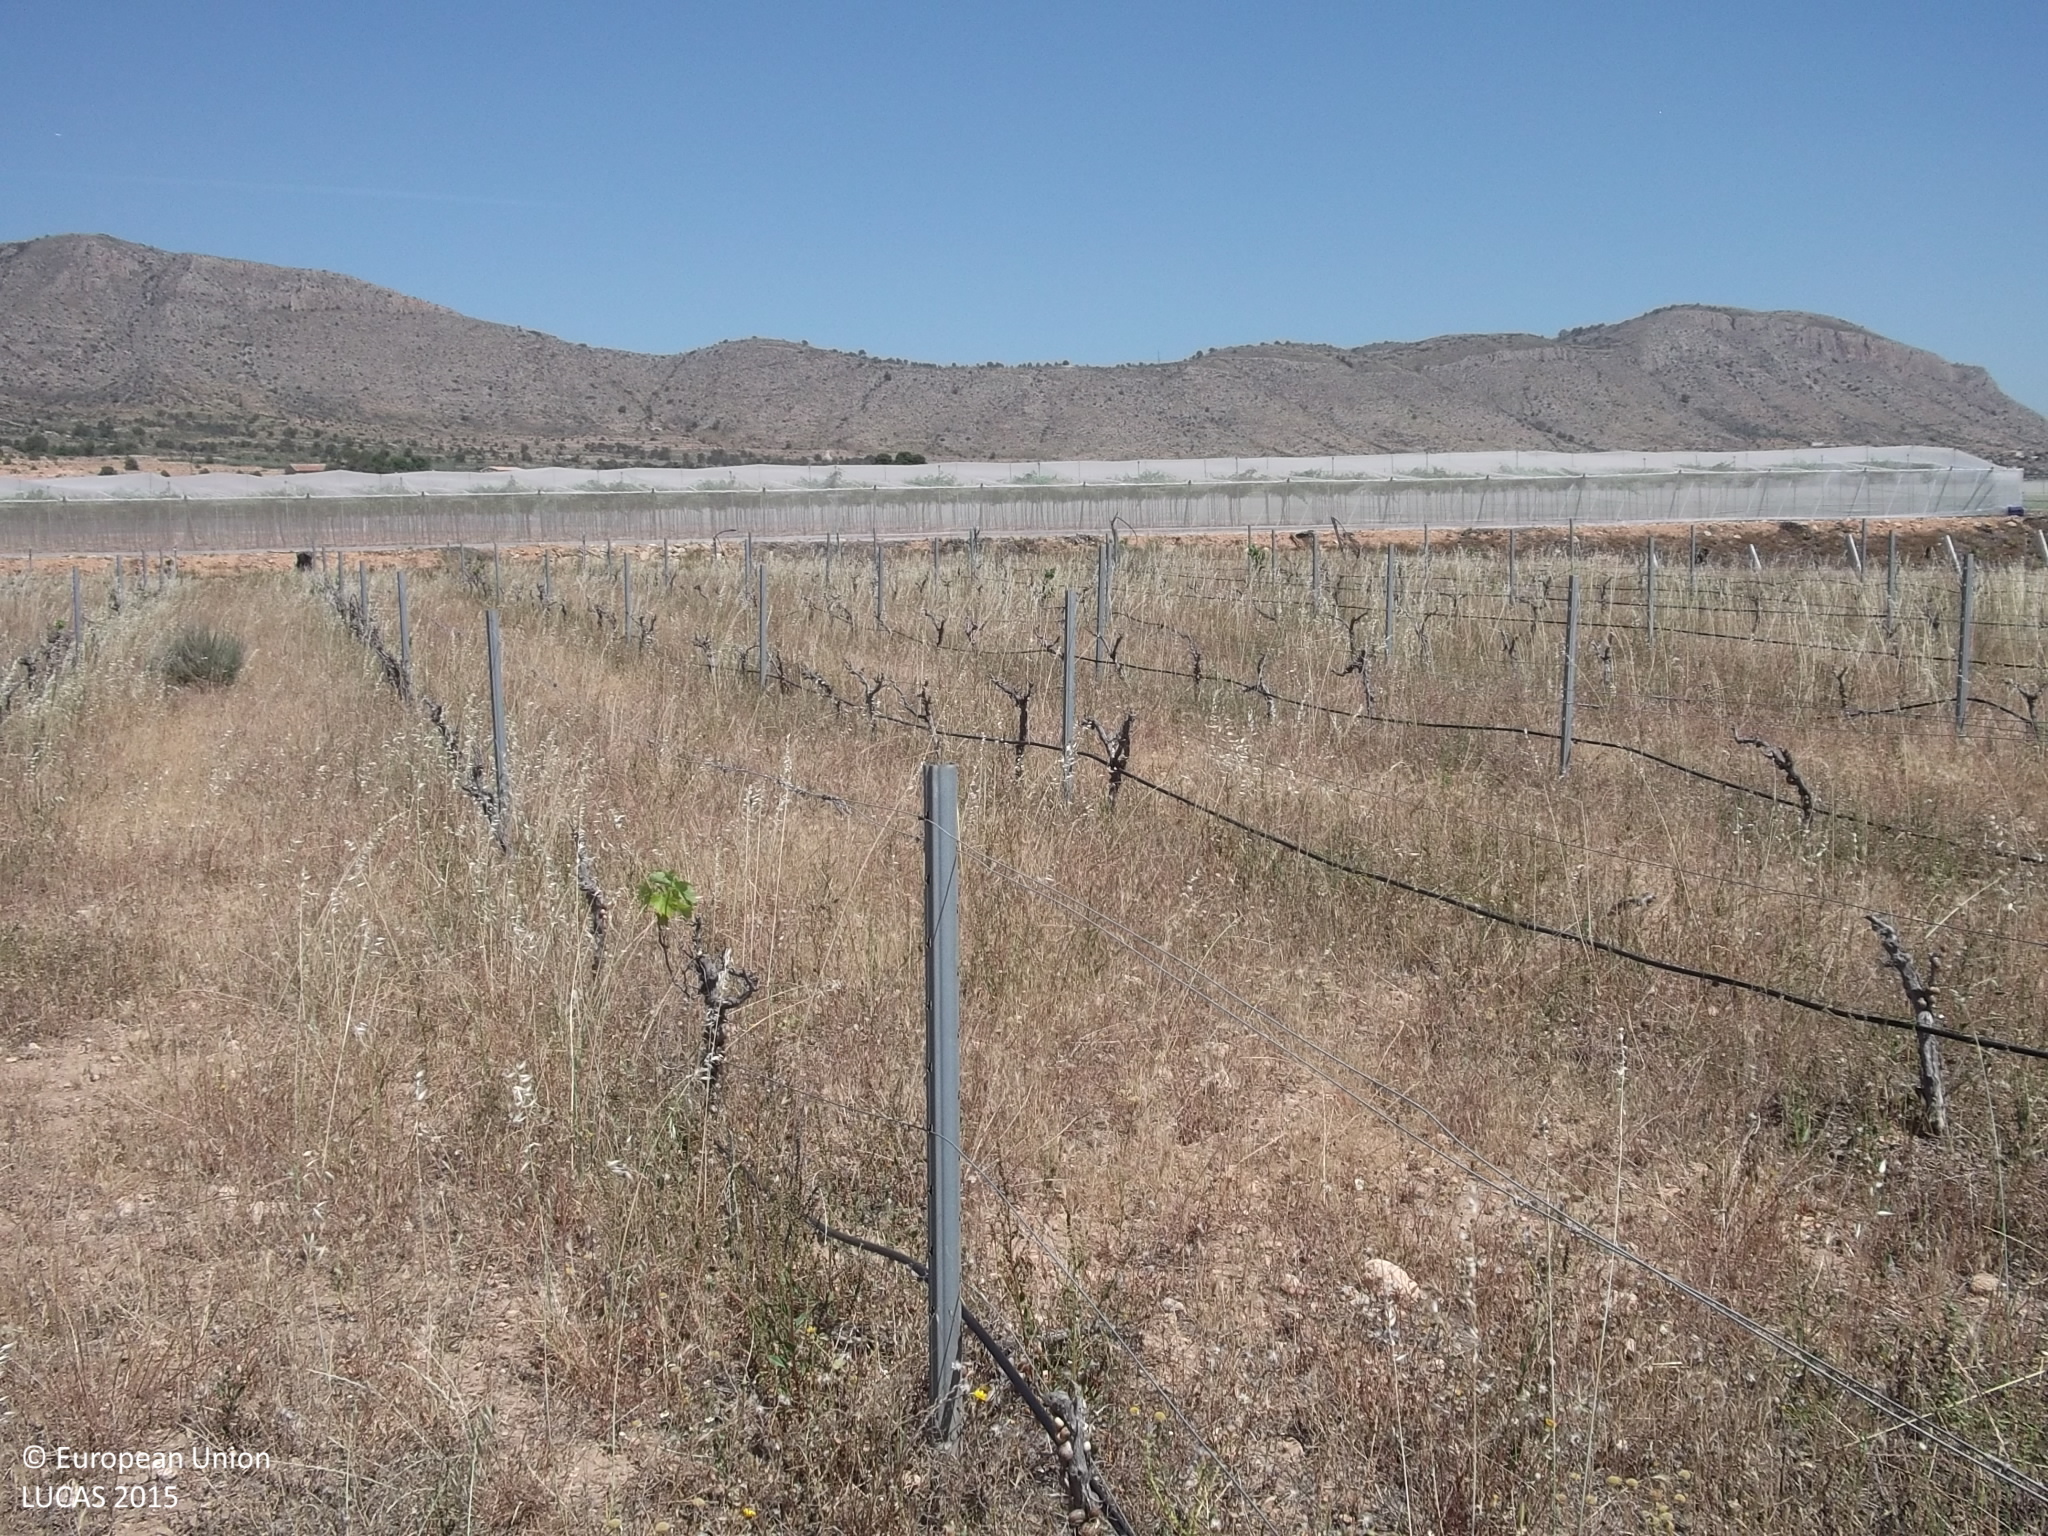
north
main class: Cropland
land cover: Vineyards
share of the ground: < 10 %
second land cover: Grassland without tree/shrub cover
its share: > 75 %
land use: Agriculture (excluding fallow land and kitchen gardens)
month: May
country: ES
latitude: 38.3088
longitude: -0.8853
